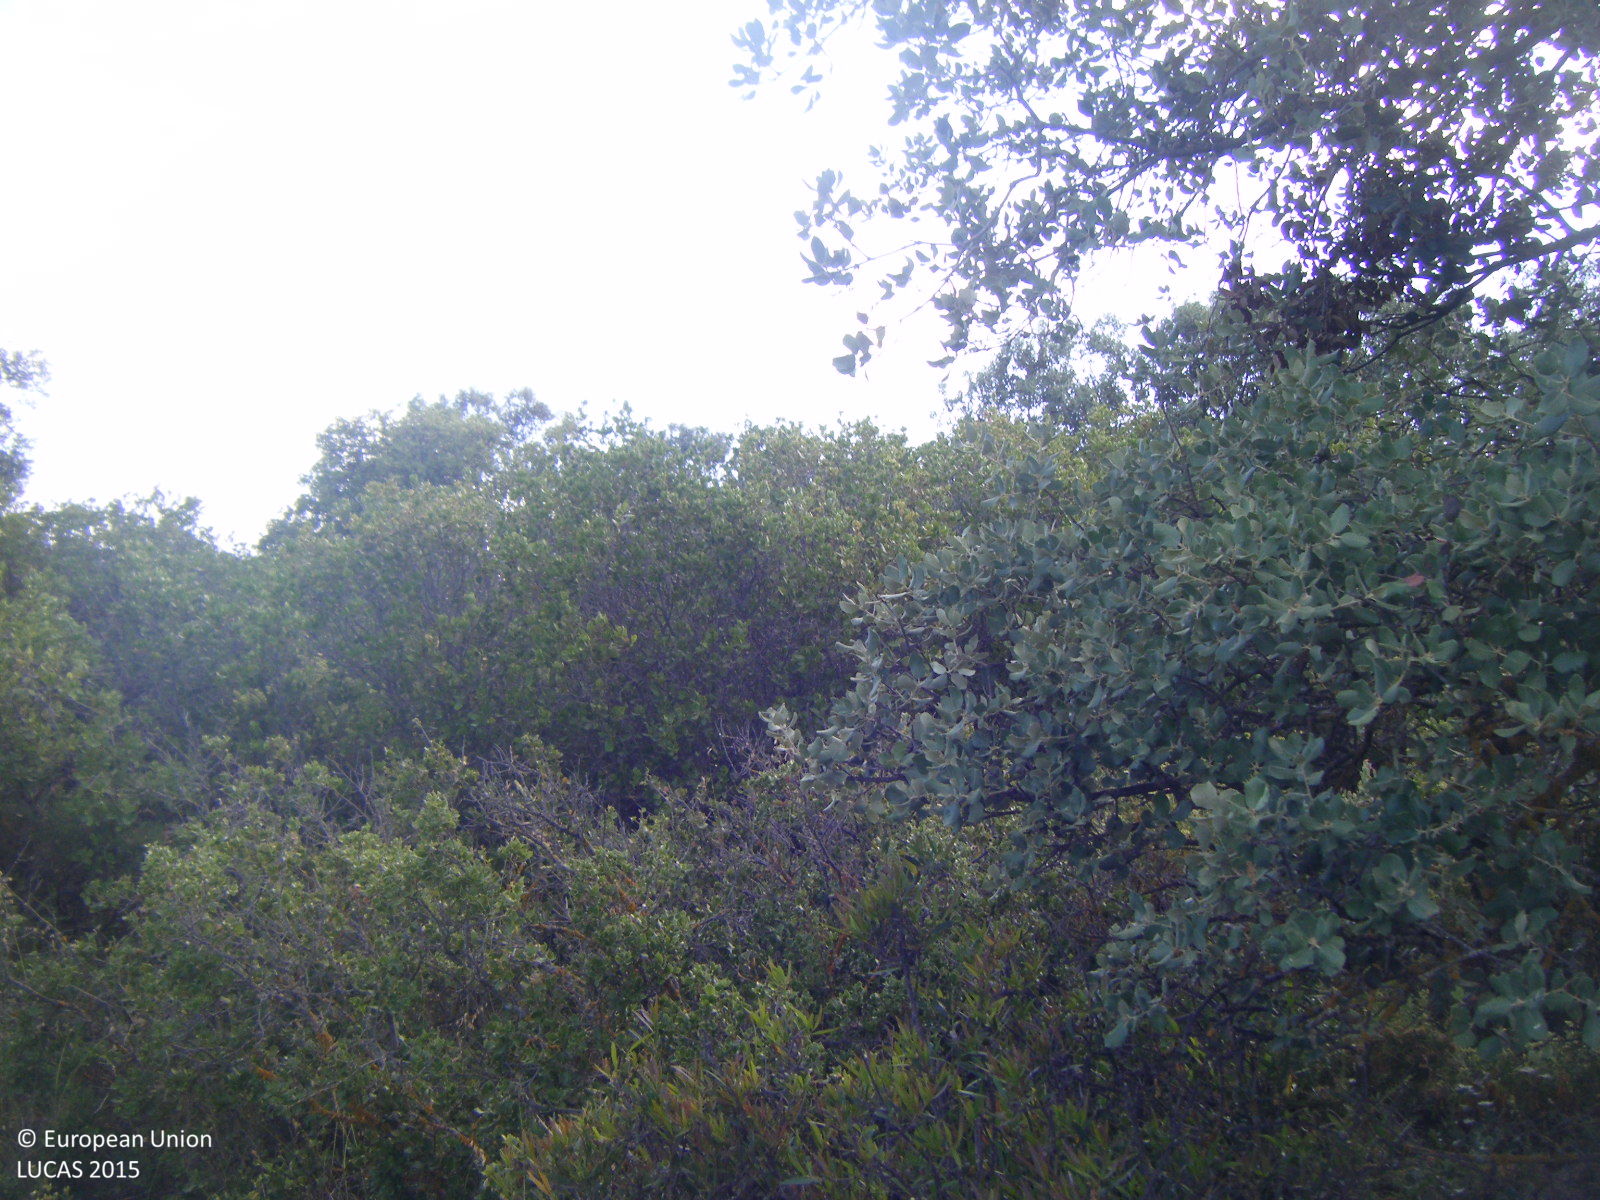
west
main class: Woodland
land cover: Broadleaved woodland
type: broadleaved evergreen forest
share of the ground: 10 - 25 %
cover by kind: shrubs 85 %, broadleaved forest trees 15 %
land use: Semi-natural and natural areas not in use
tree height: < 5 m
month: May
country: ES
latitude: 37.0322
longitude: -4.3957
